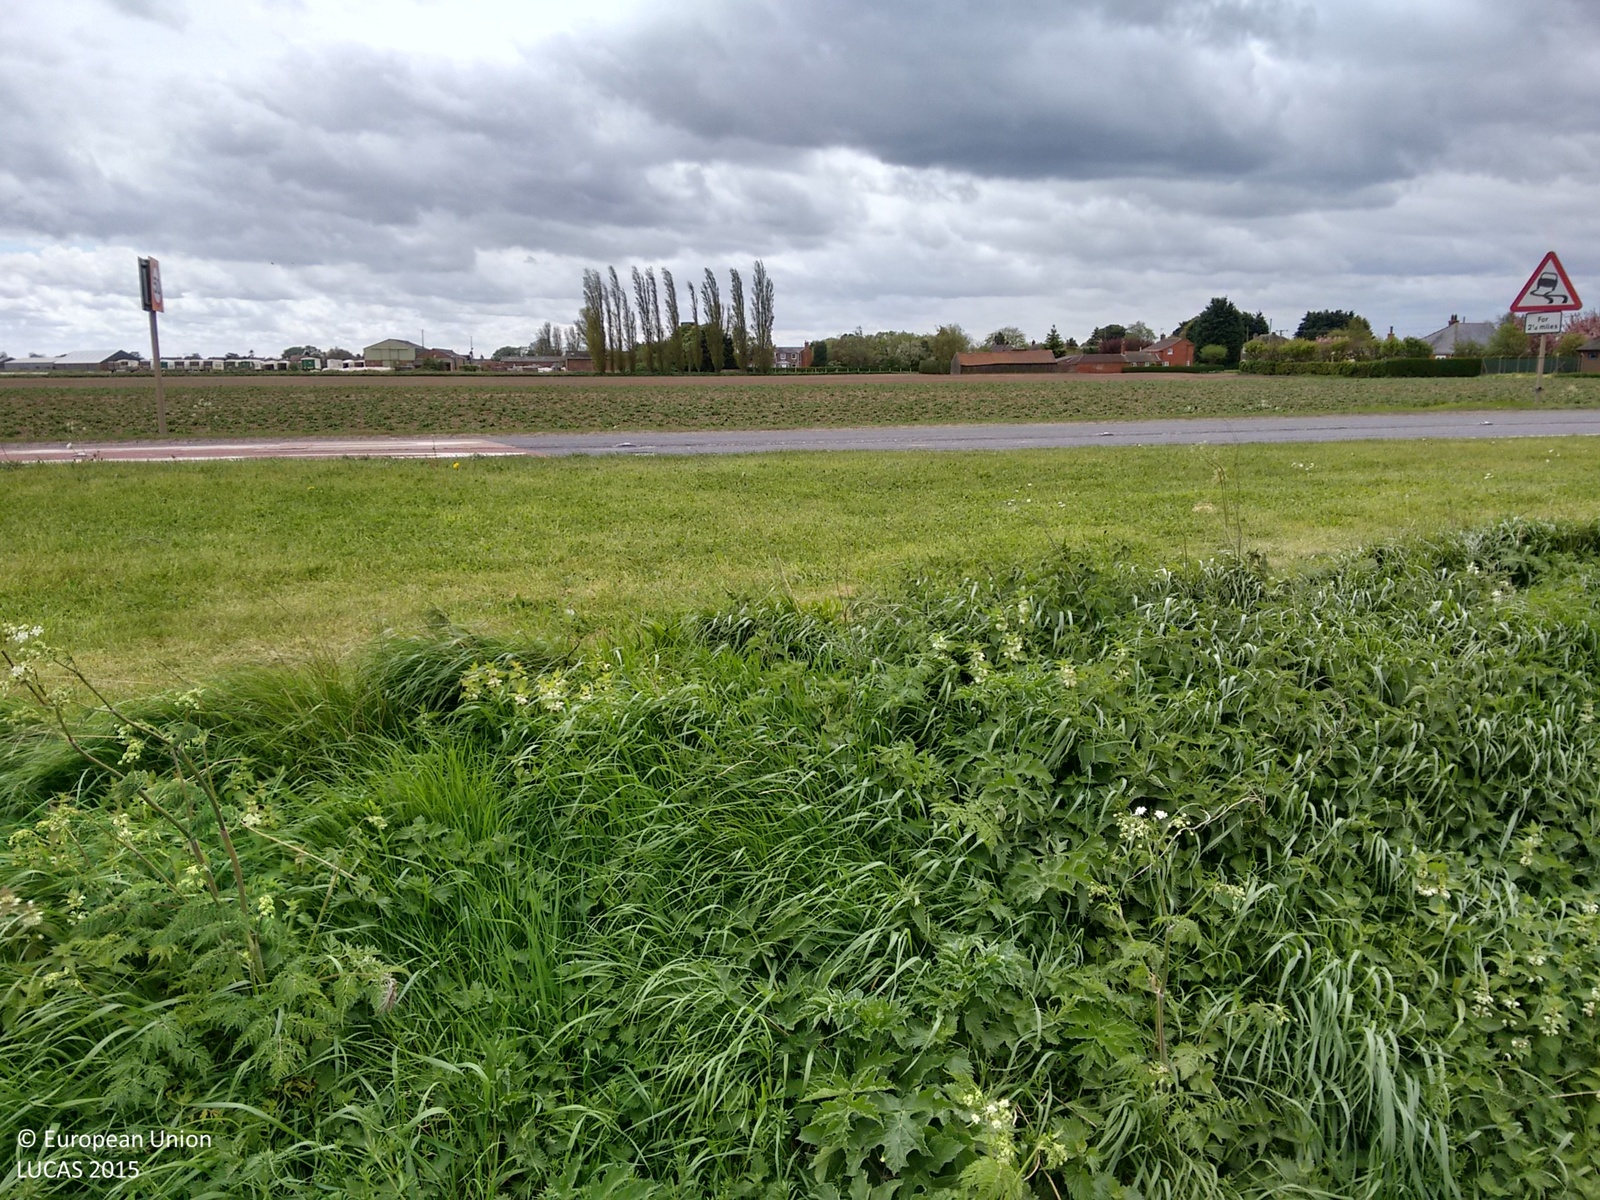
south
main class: Grassland
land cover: Grassland without tree/shrub cover
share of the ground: > 75 %
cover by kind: herbaceous plants 100 %
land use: Agriculture (excluding fallow land and kitchen gardens)
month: May
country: GB
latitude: 52.9921
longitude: 0.0614
